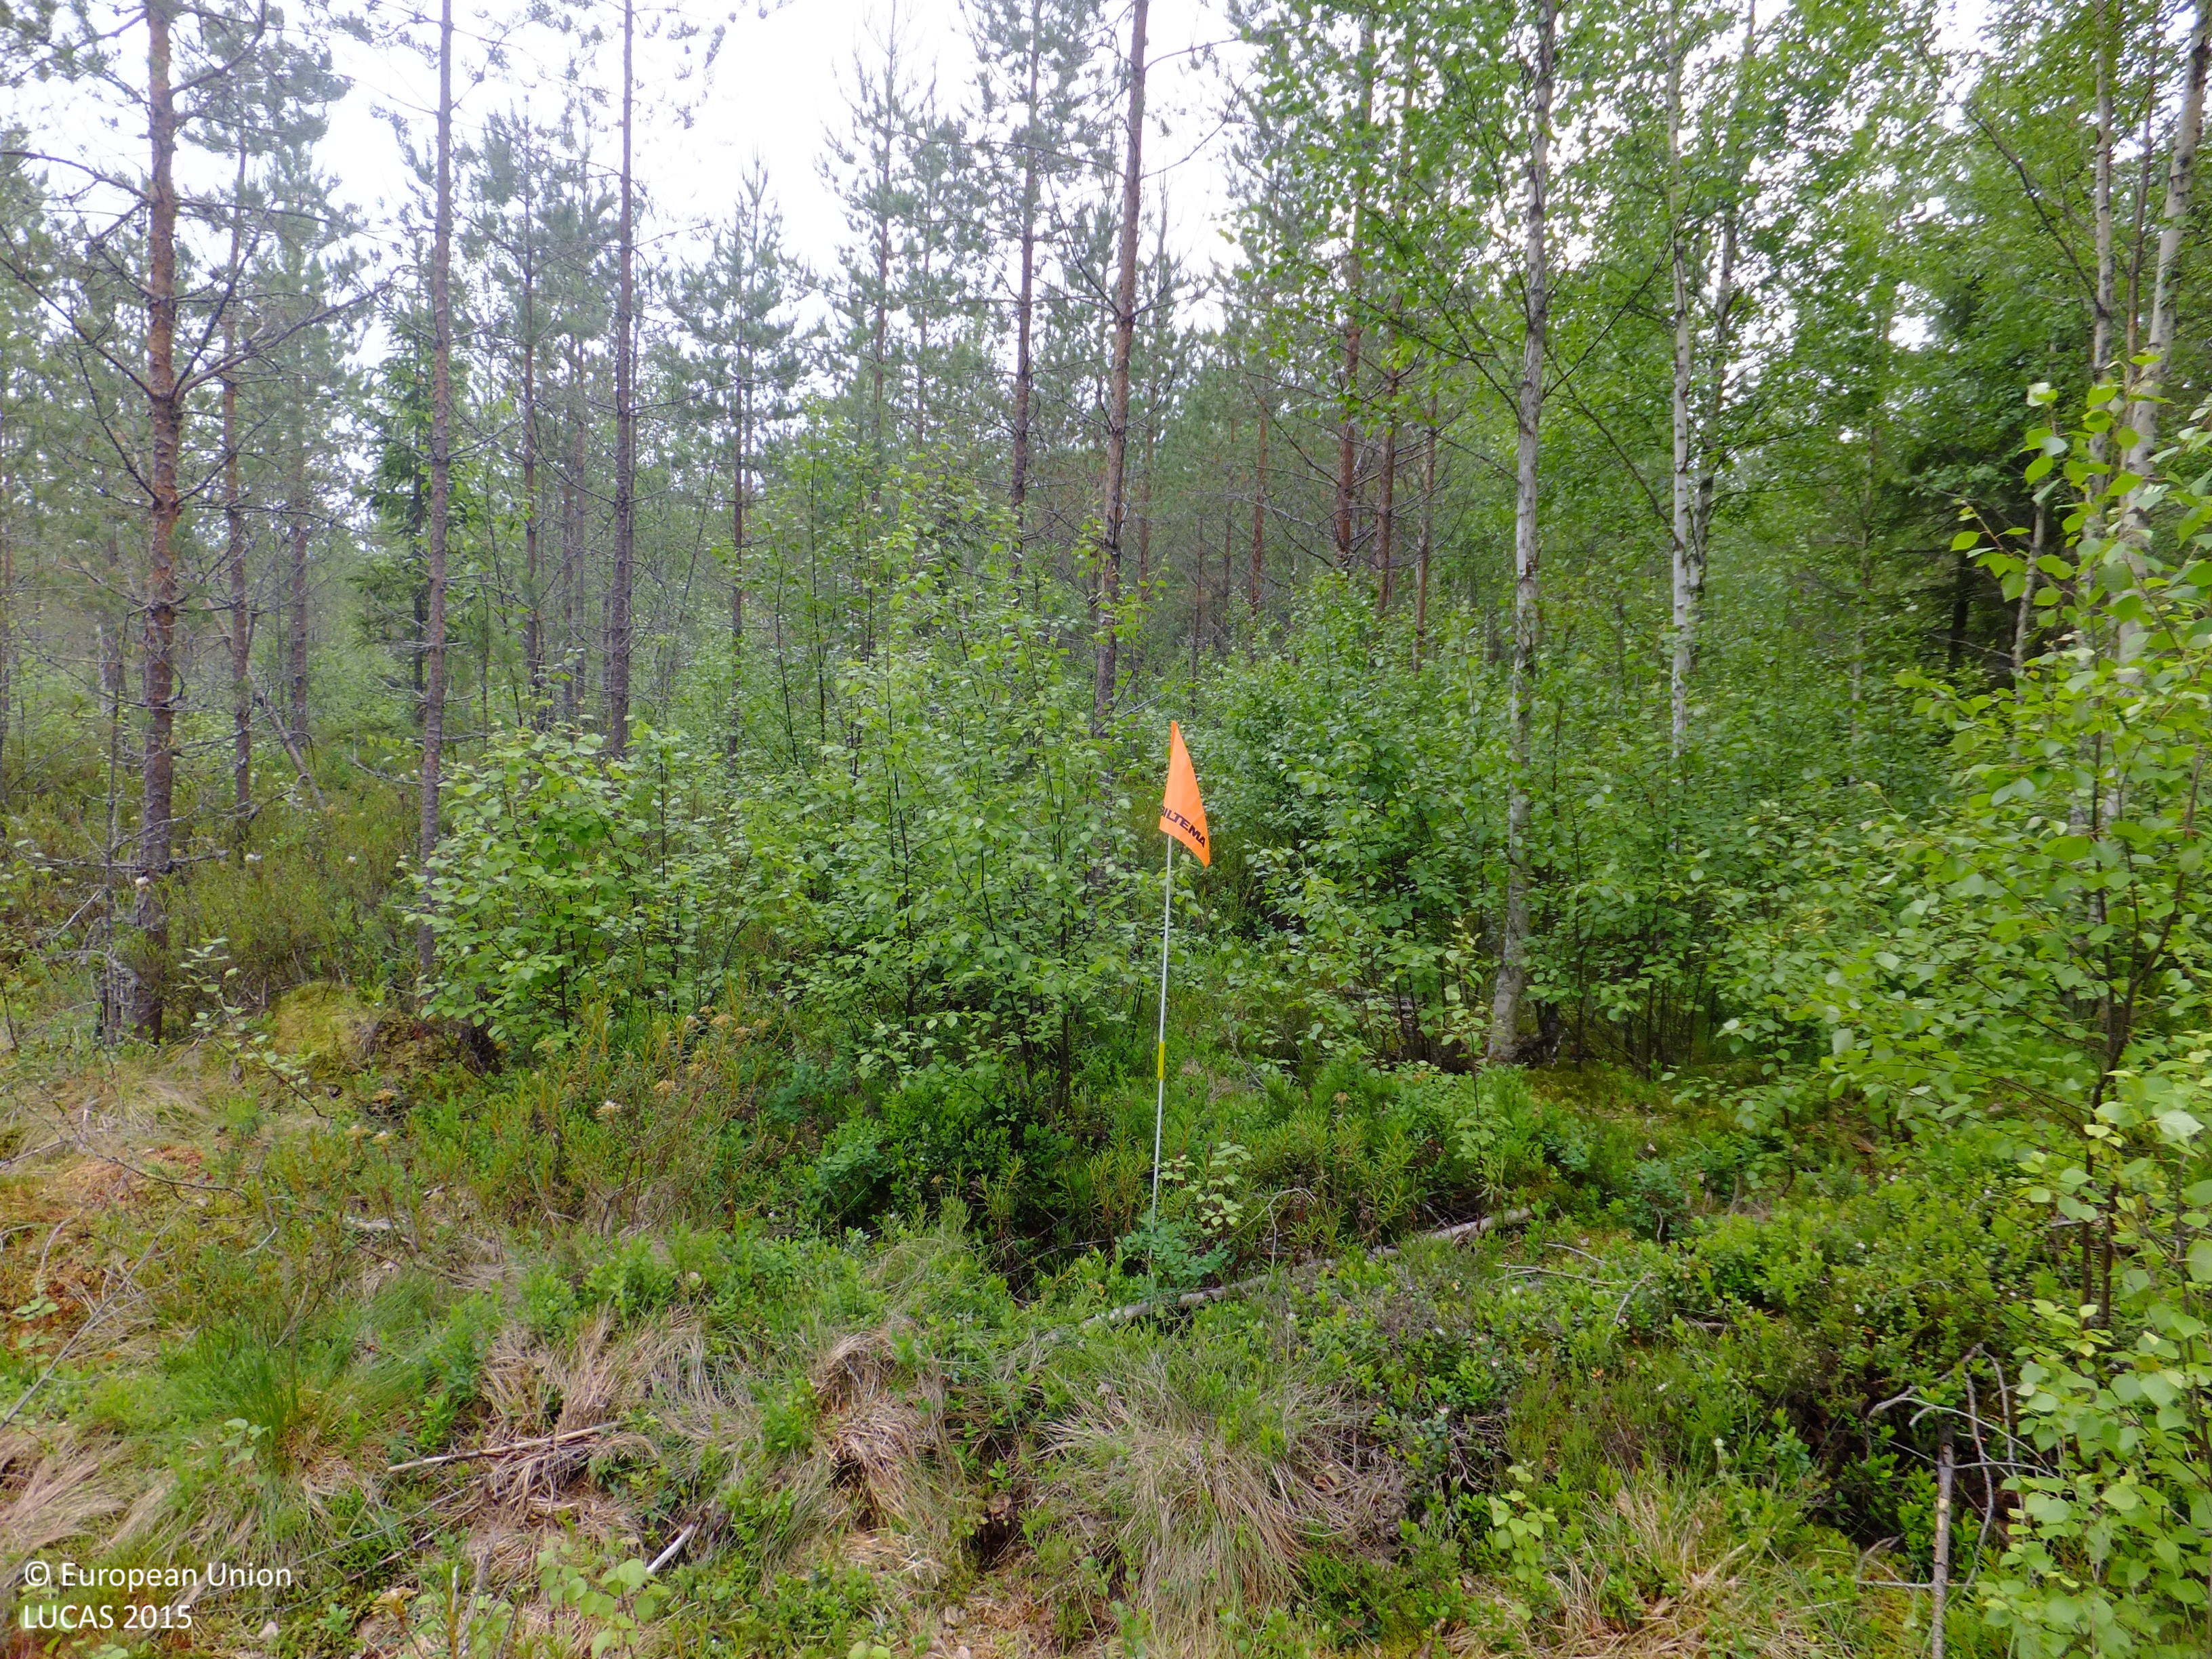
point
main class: Woodland
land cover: Pine dominated mixed woodland
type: boreal forest
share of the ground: 50 - 75 %
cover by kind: coniferous forest trees 40 %, broadleaved forest trees 20 %, shrubs 20 %, lichens and mosses 15 %, herbaceous plants 5 %
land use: Forestry
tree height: > 5 m
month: July
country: FI
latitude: 63.1050
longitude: 24.6509
